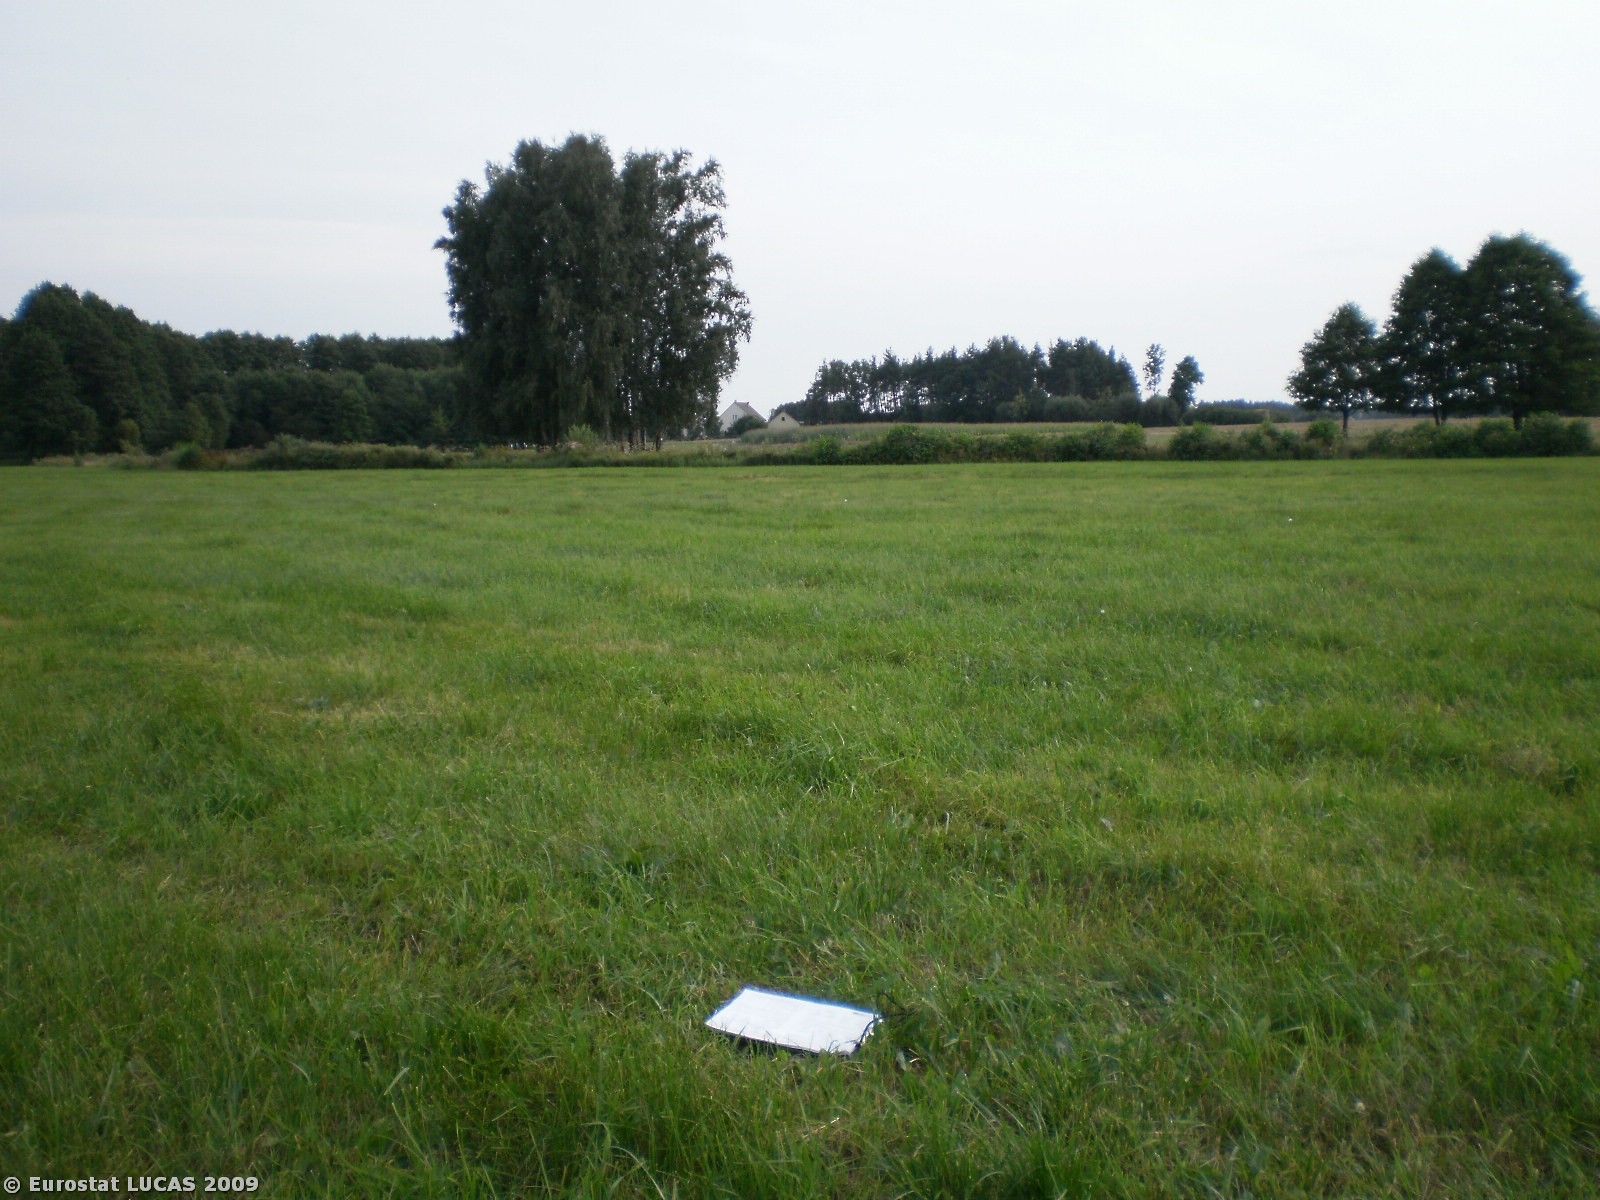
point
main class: Grassland
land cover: Grassland without tree/shrub cover
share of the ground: > 75 %
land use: Agriculture (excluding fallow land and kitchen gardens)
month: August
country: PL
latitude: 52.9796
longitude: 21.8665
